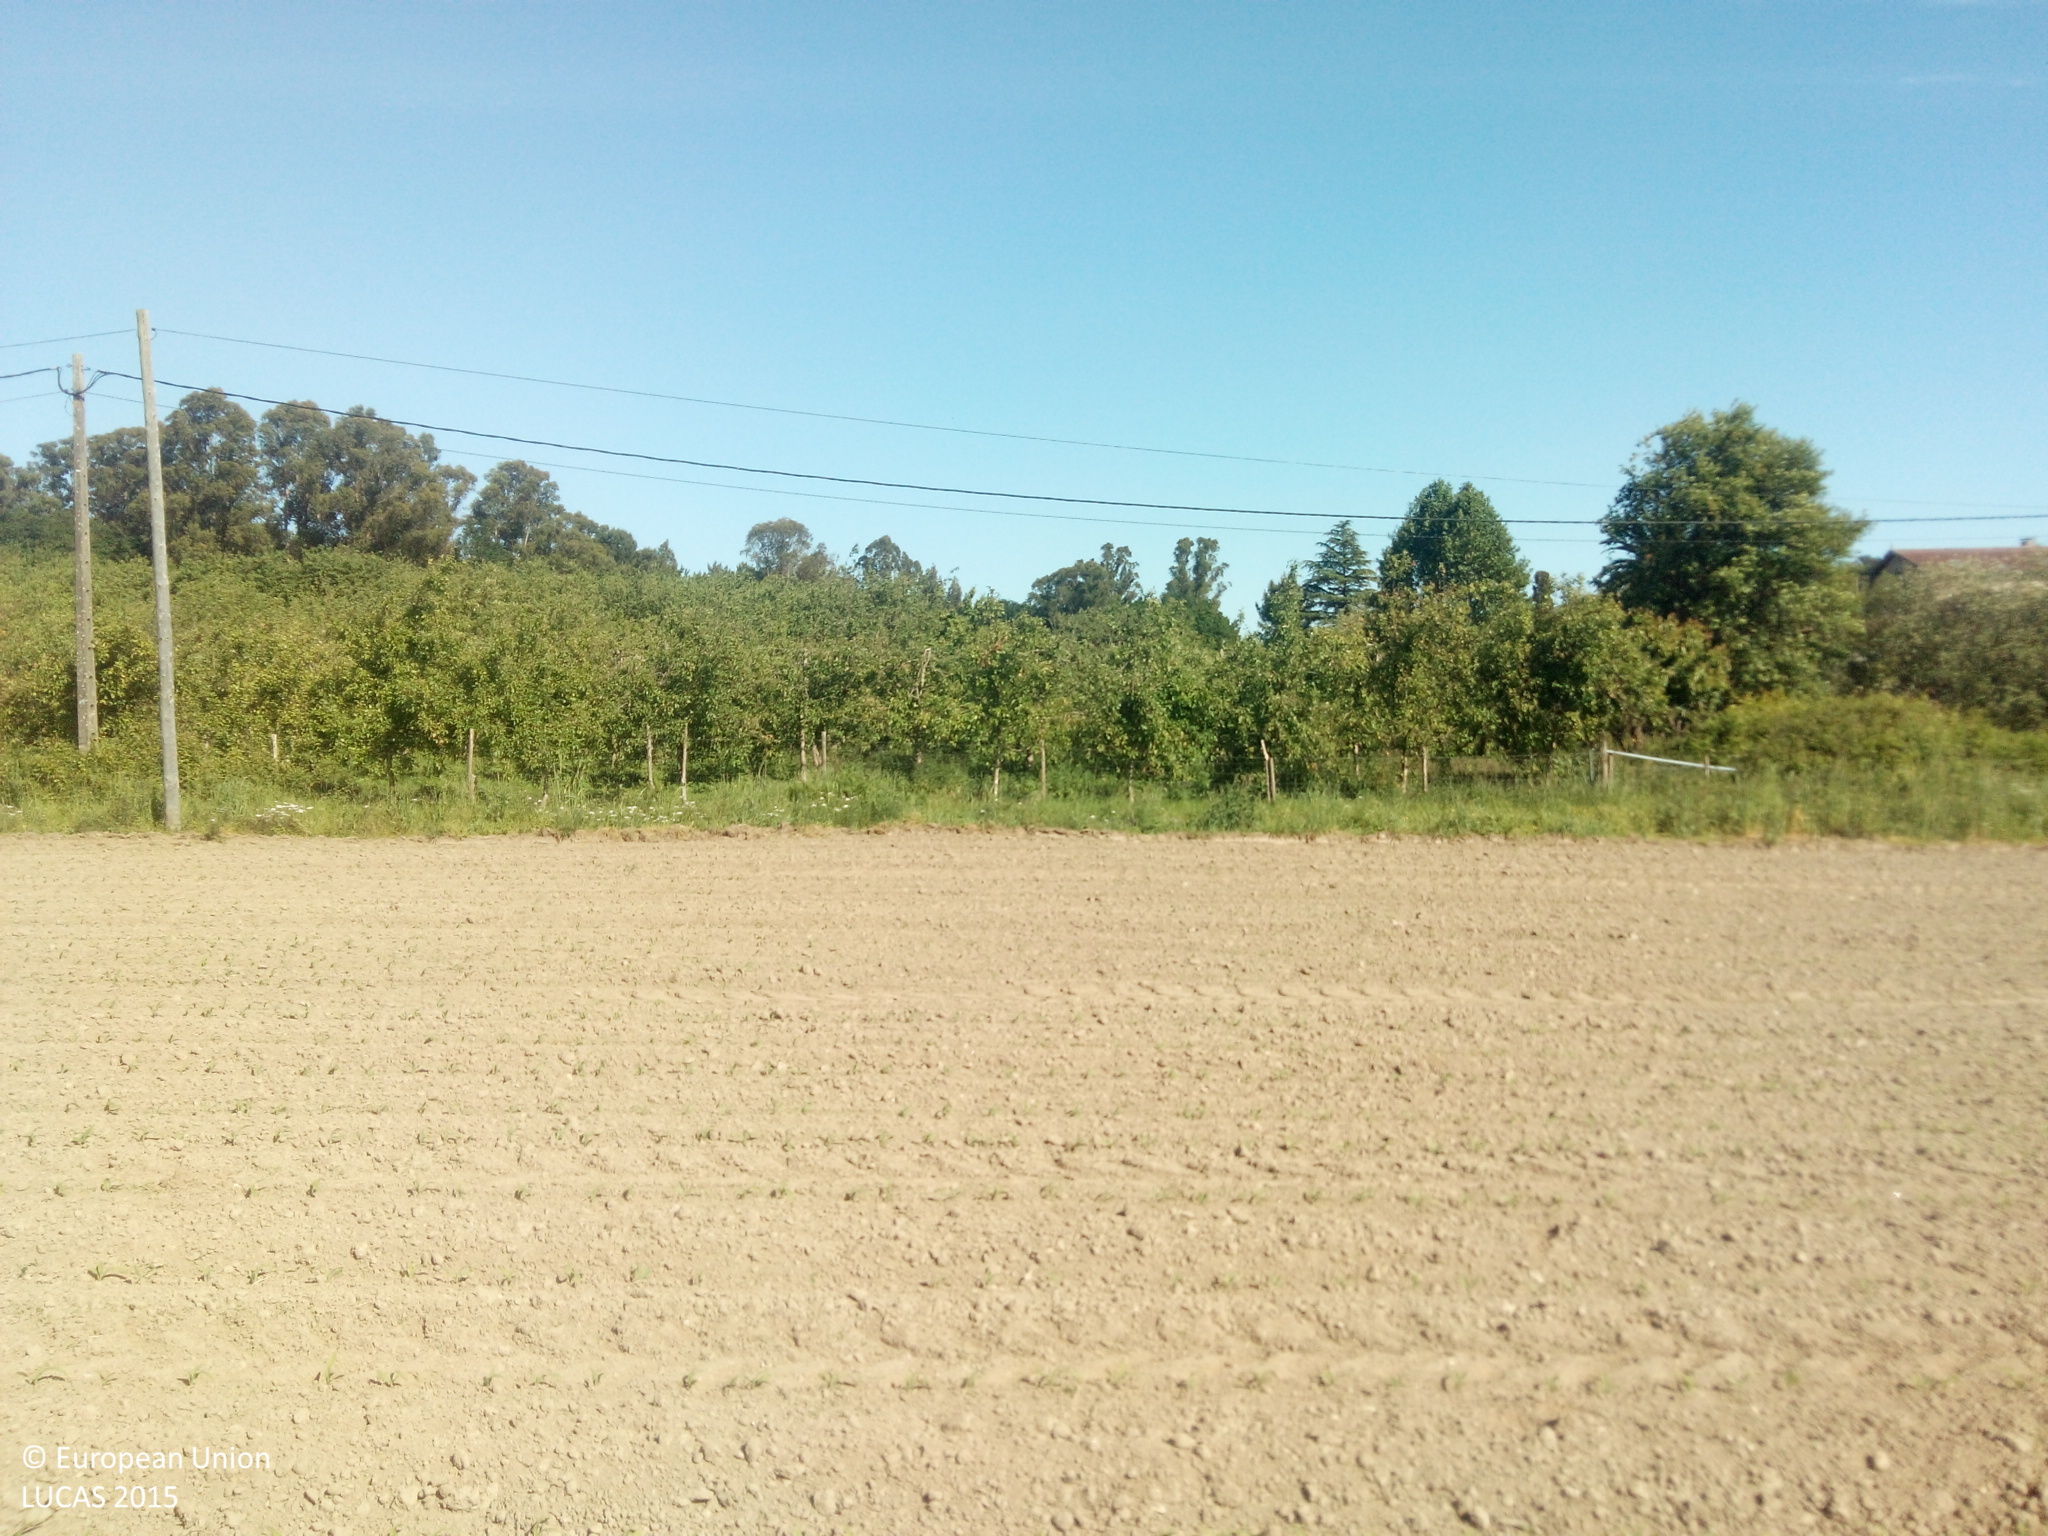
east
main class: Cropland
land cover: Maize
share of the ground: > 75 %
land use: Agriculture (excluding fallow land and kitchen gardens)
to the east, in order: Maize; Ditches and canals; Electric lines; Grass margins; Paved roads, cycling and walking lanes; Grass margins; Ditches and canals; Fences; Electric lines; Apple fruit; Fences; Spontaneously vegetated surfaces; Potatoes; Other fresh vegetables; Spontaneously vegetated surfaces; Grass margins; Tracks; Broadleaved woodland
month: May
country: ES
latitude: 42.7149
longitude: -8.4519
